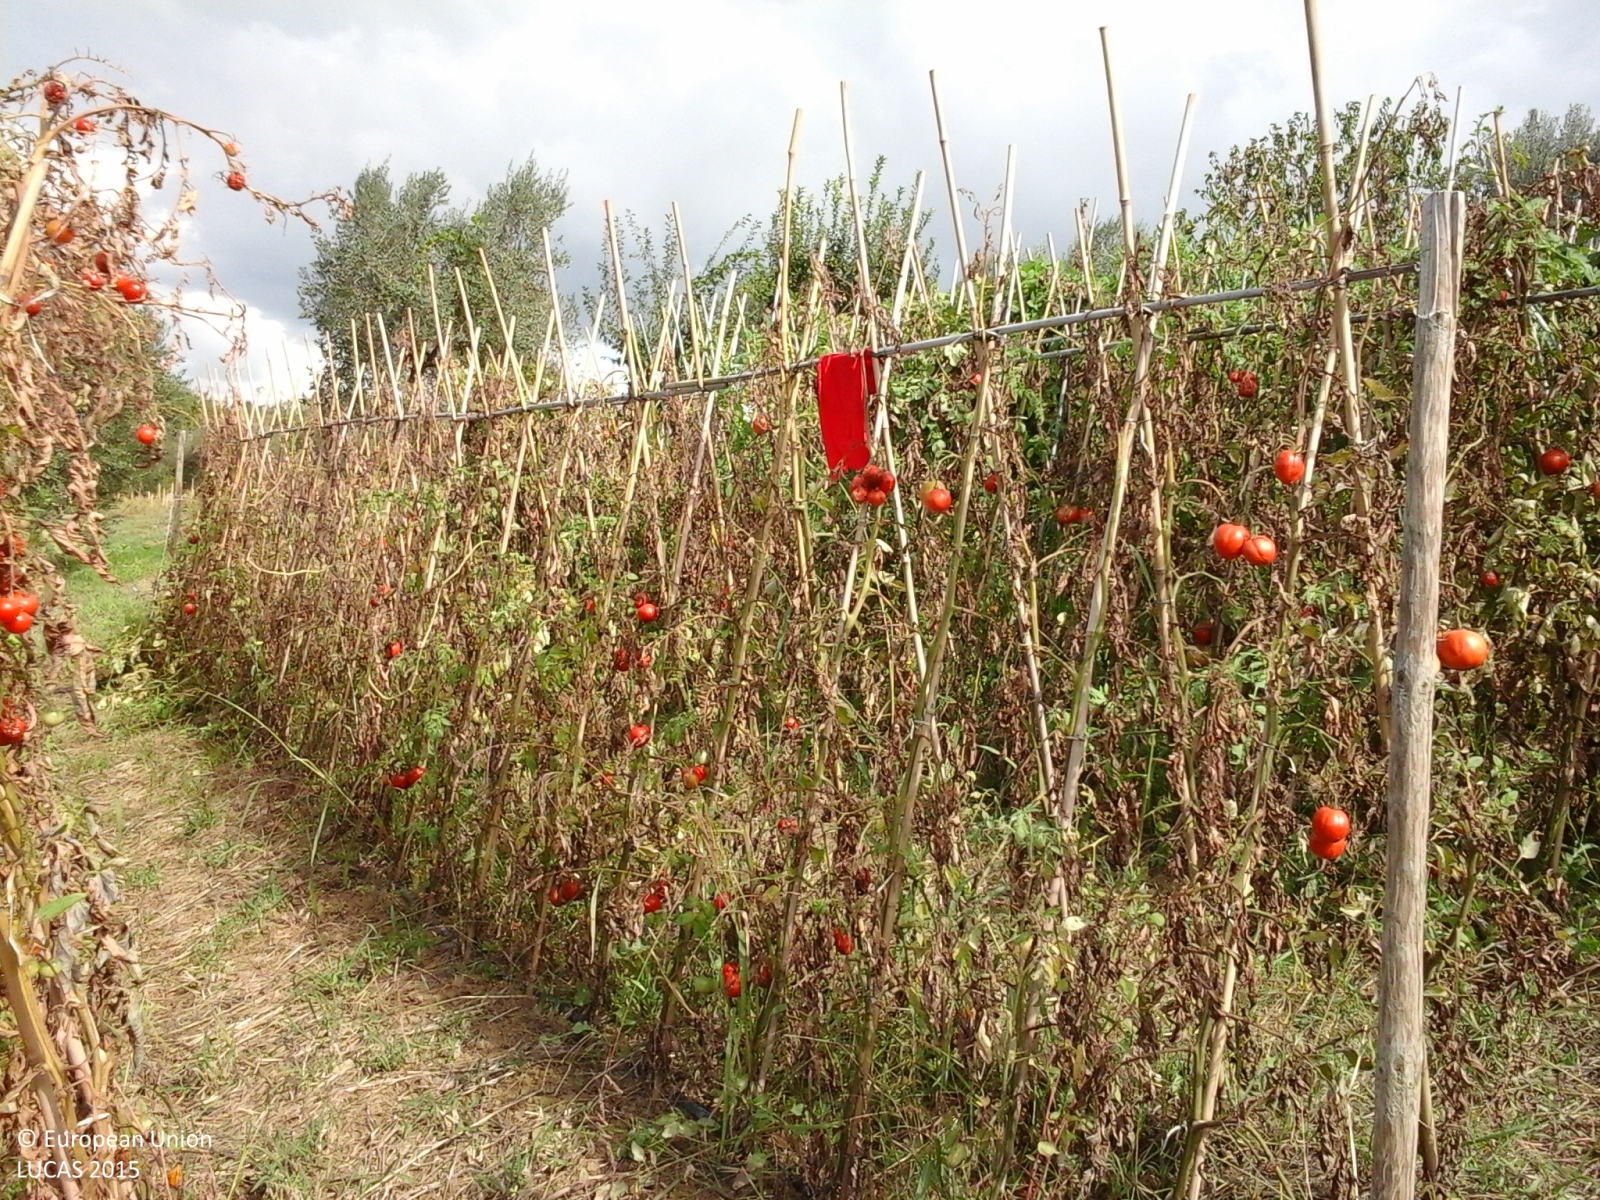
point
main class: Cropland
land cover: Tomatoes
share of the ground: > 75 %
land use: Kitchen garden
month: September
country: IT
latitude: 42.8351
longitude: 13.8186
